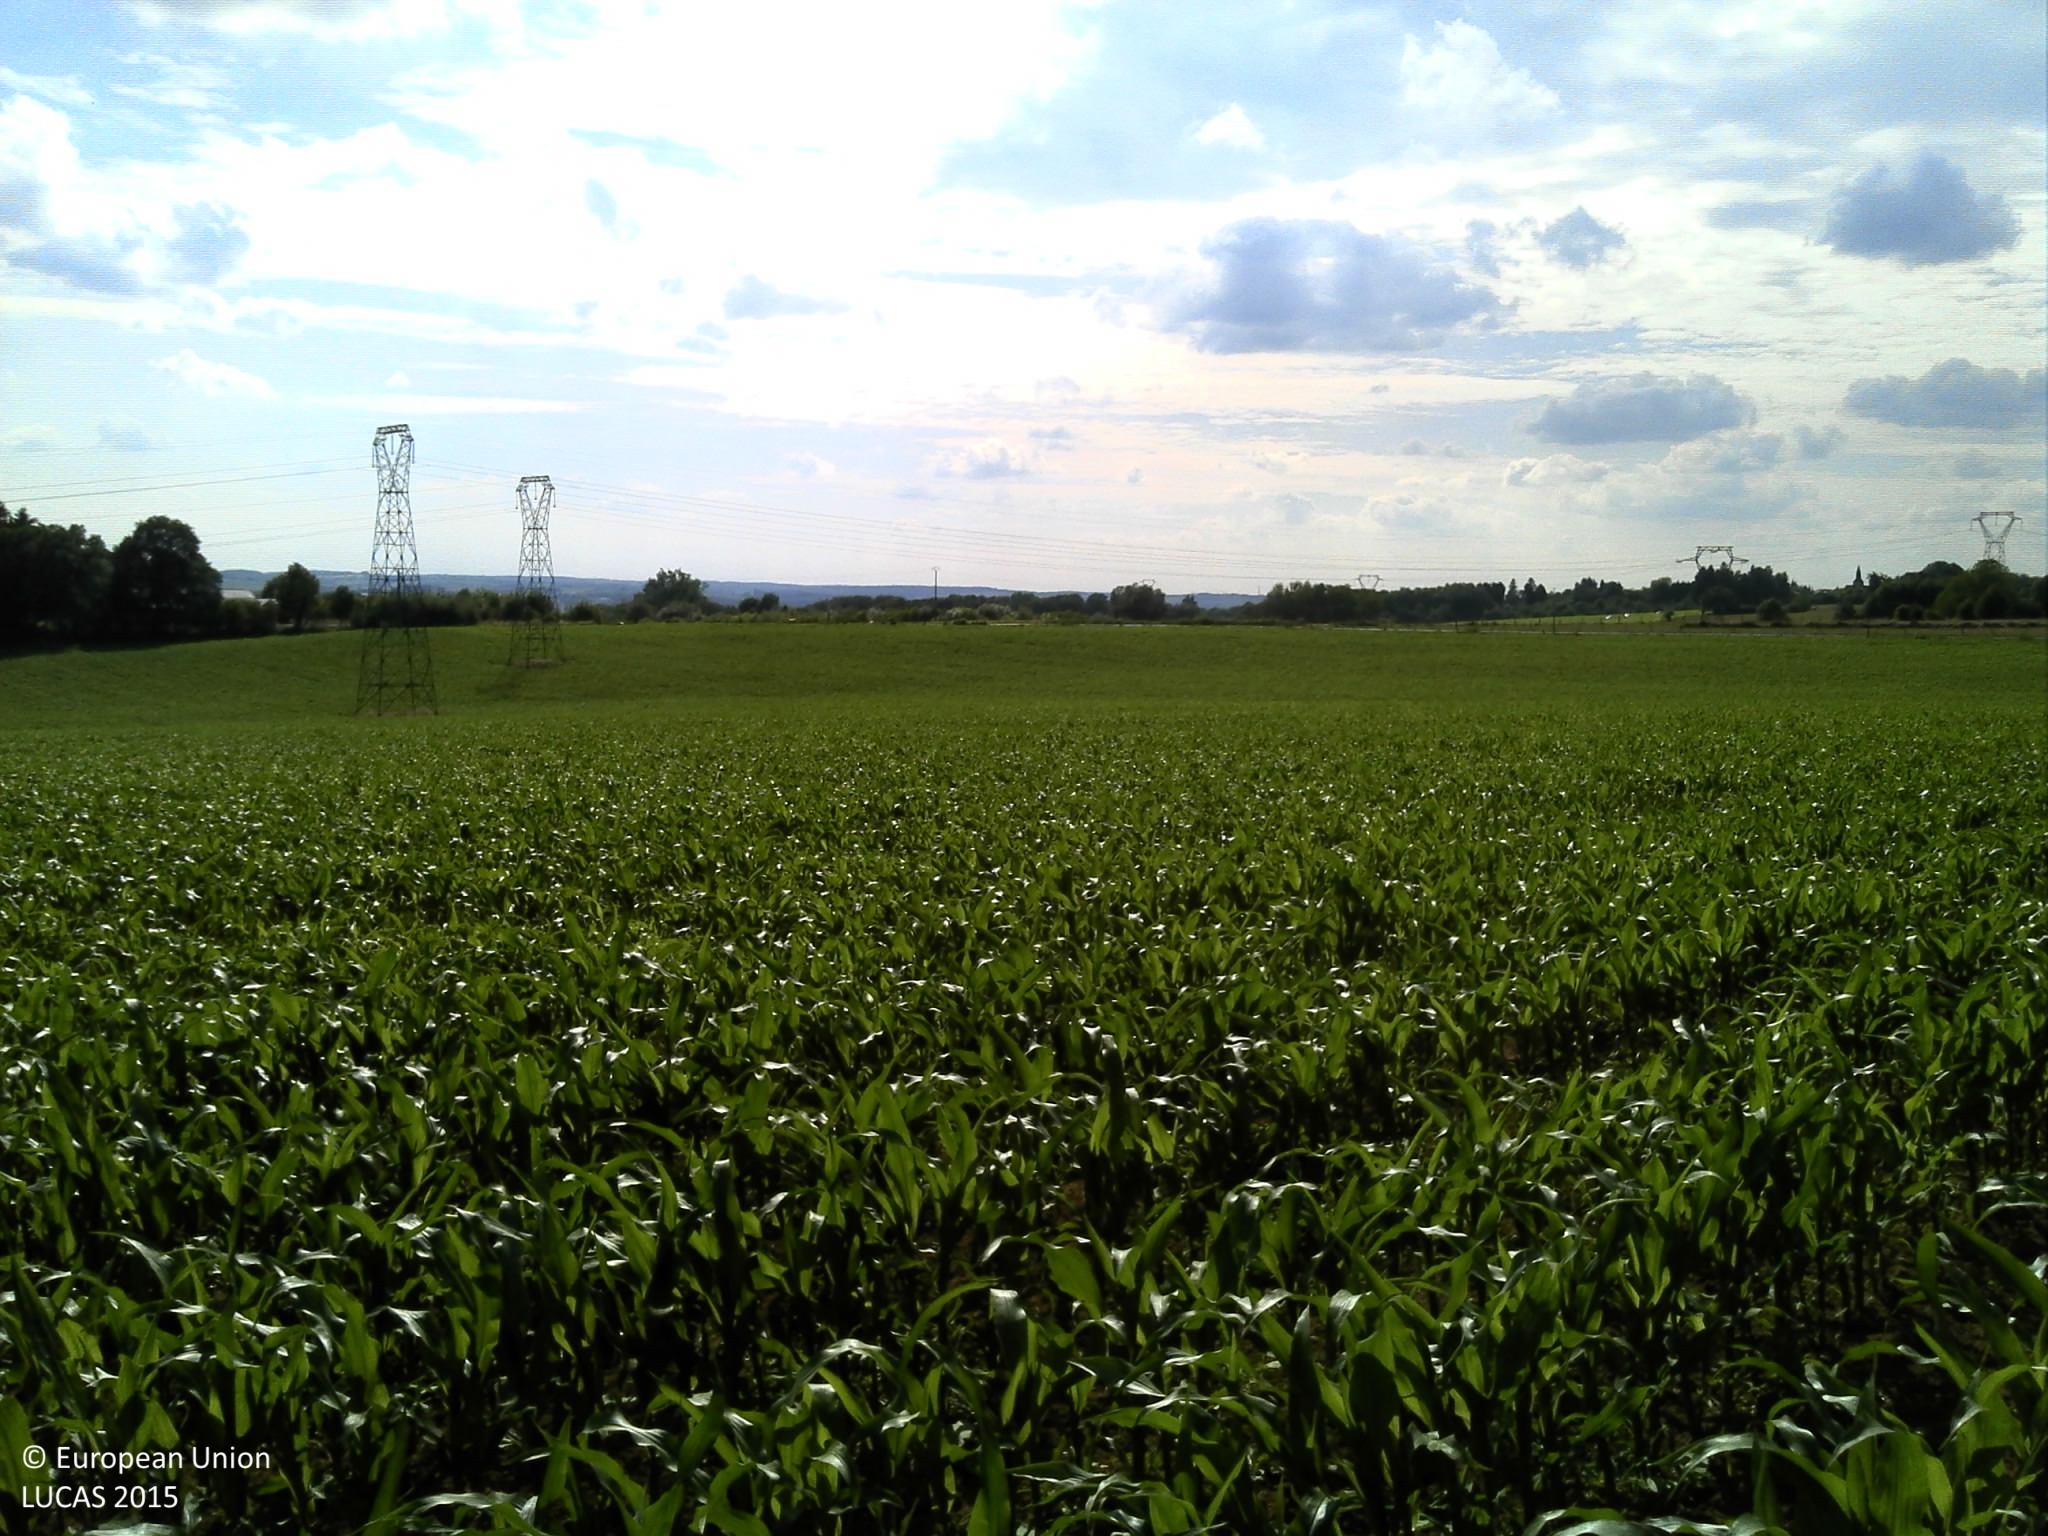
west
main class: Cropland
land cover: Maize
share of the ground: 25 - 50 %
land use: Agriculture (excluding fallow land and kitchen gardens)
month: June
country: FR
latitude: 49.7589
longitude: 4.7913
